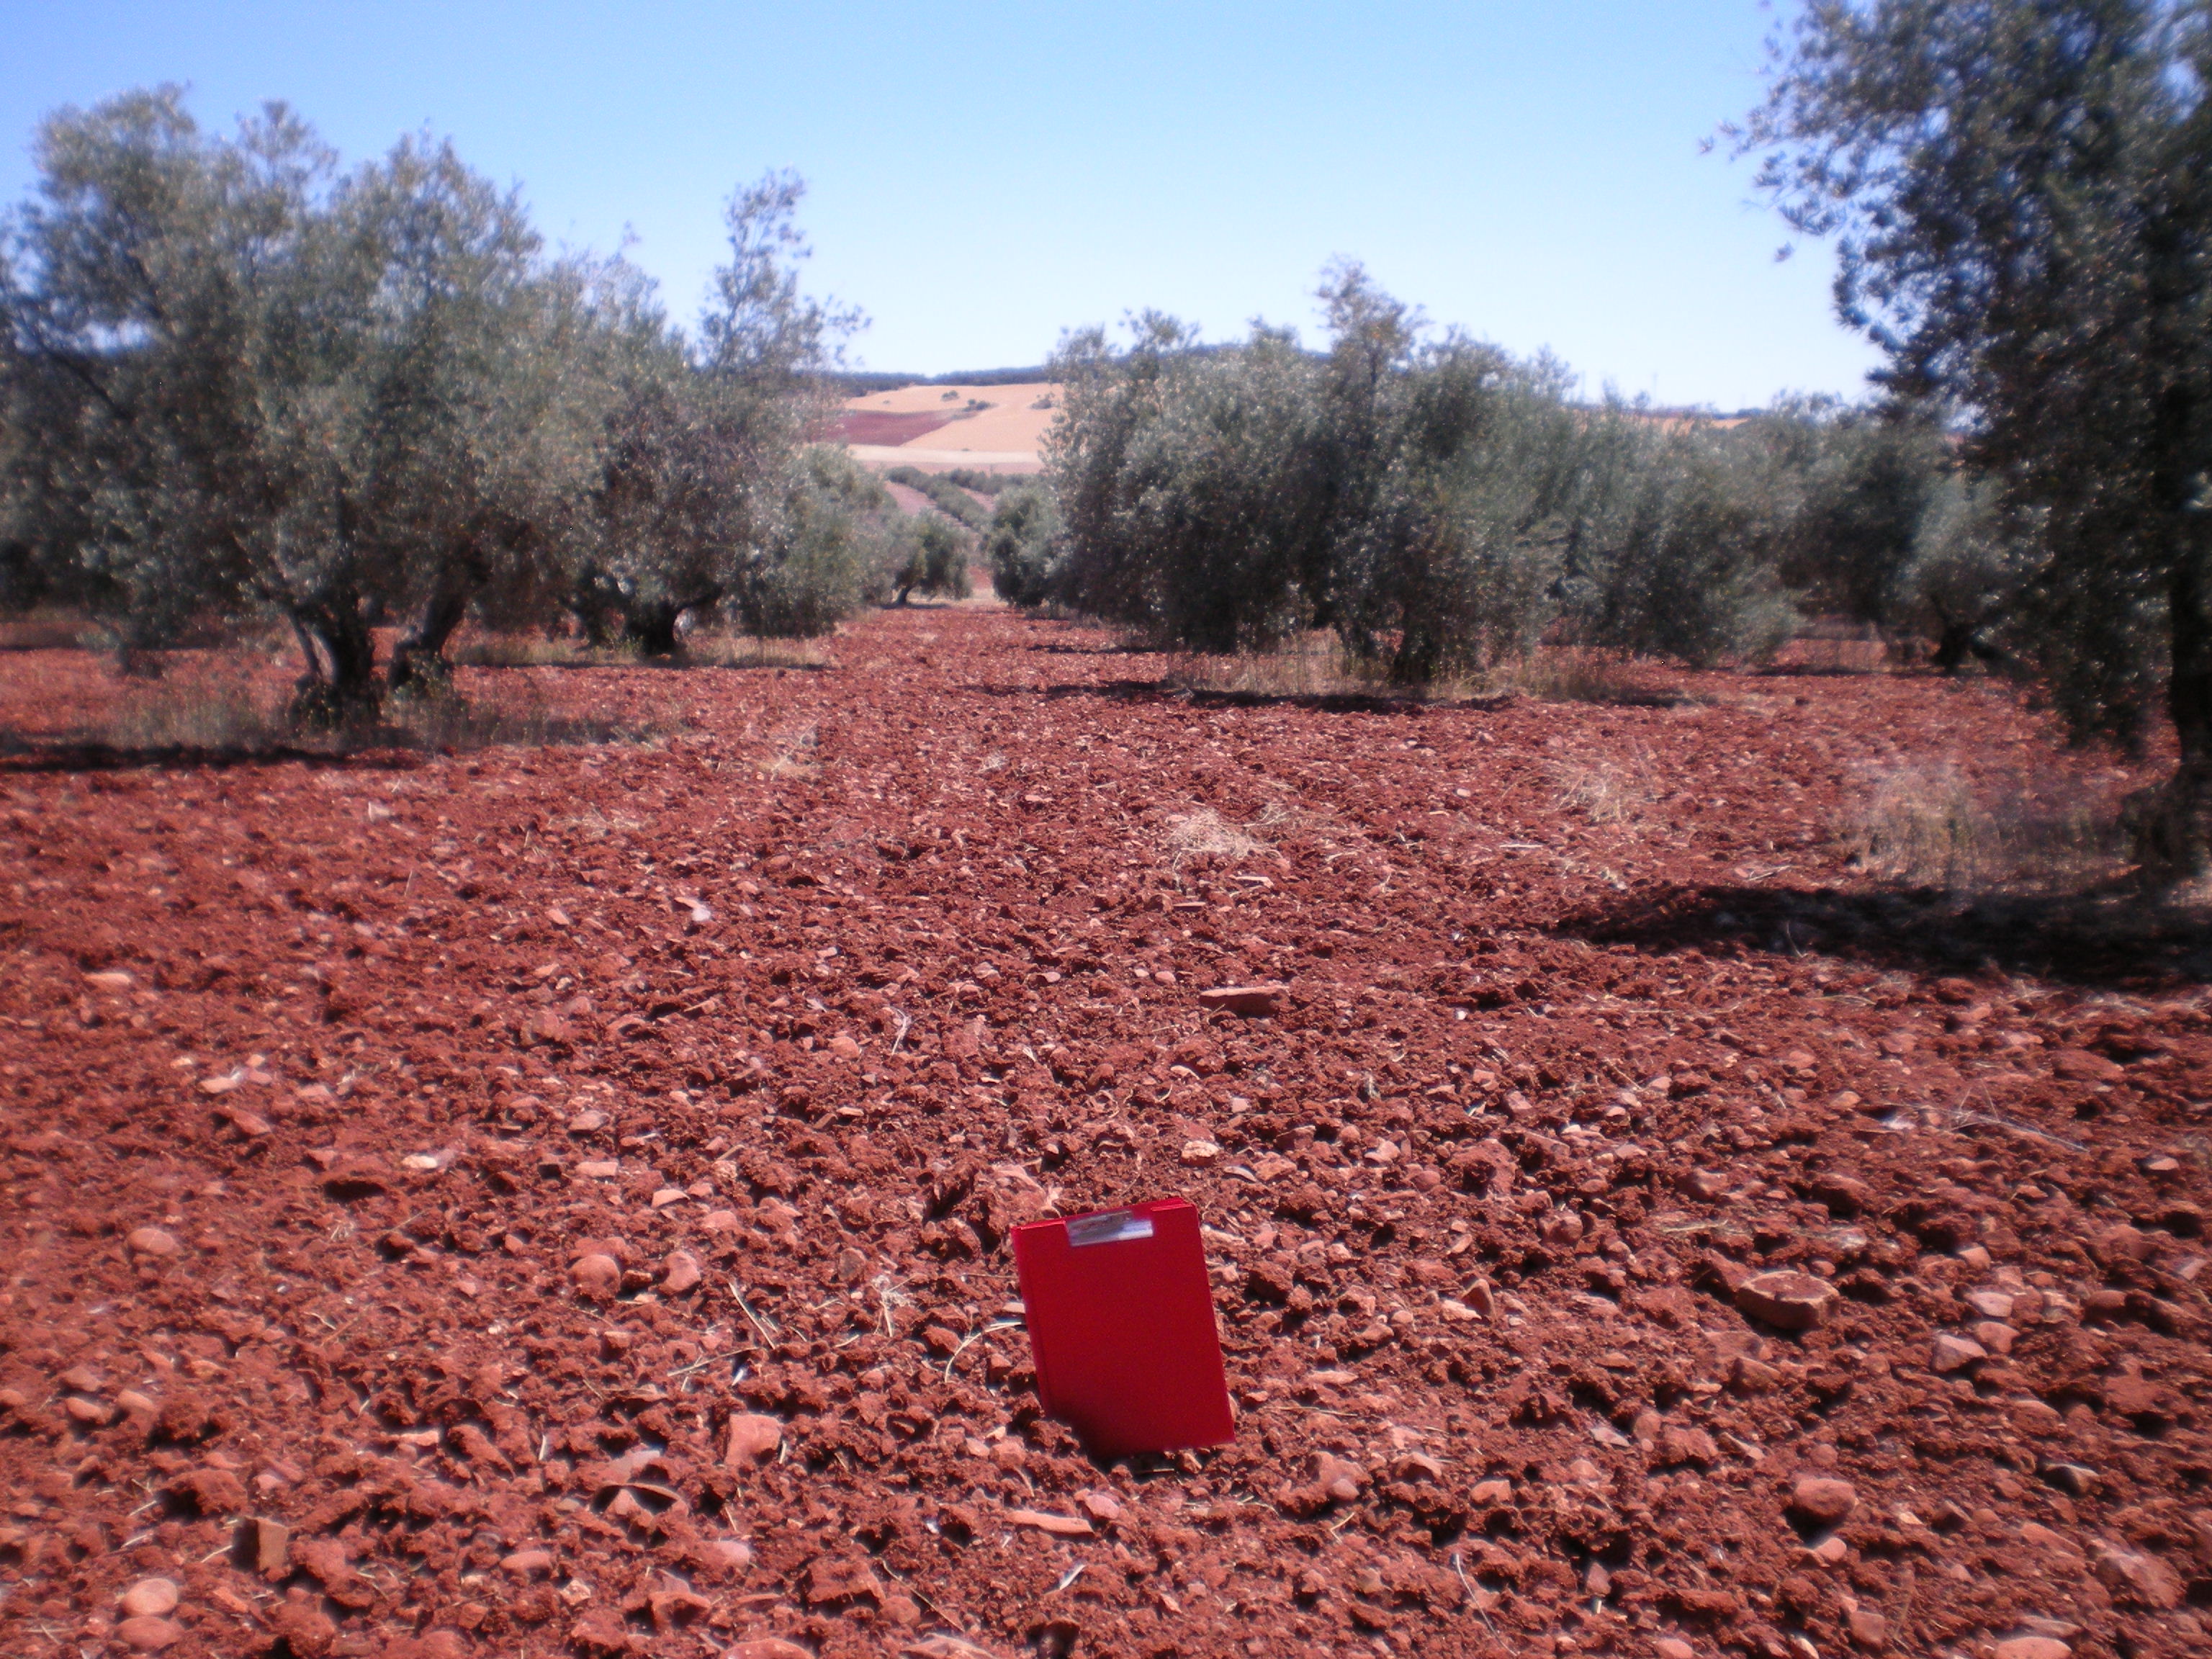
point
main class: Cropland
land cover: Olive groves
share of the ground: 10 - 25 %
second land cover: Other bare soil
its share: > 75 %
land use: Agriculture (excluding fallow land and kitchen gardens)
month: May
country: ES
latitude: 38.5996
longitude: -3.4783
